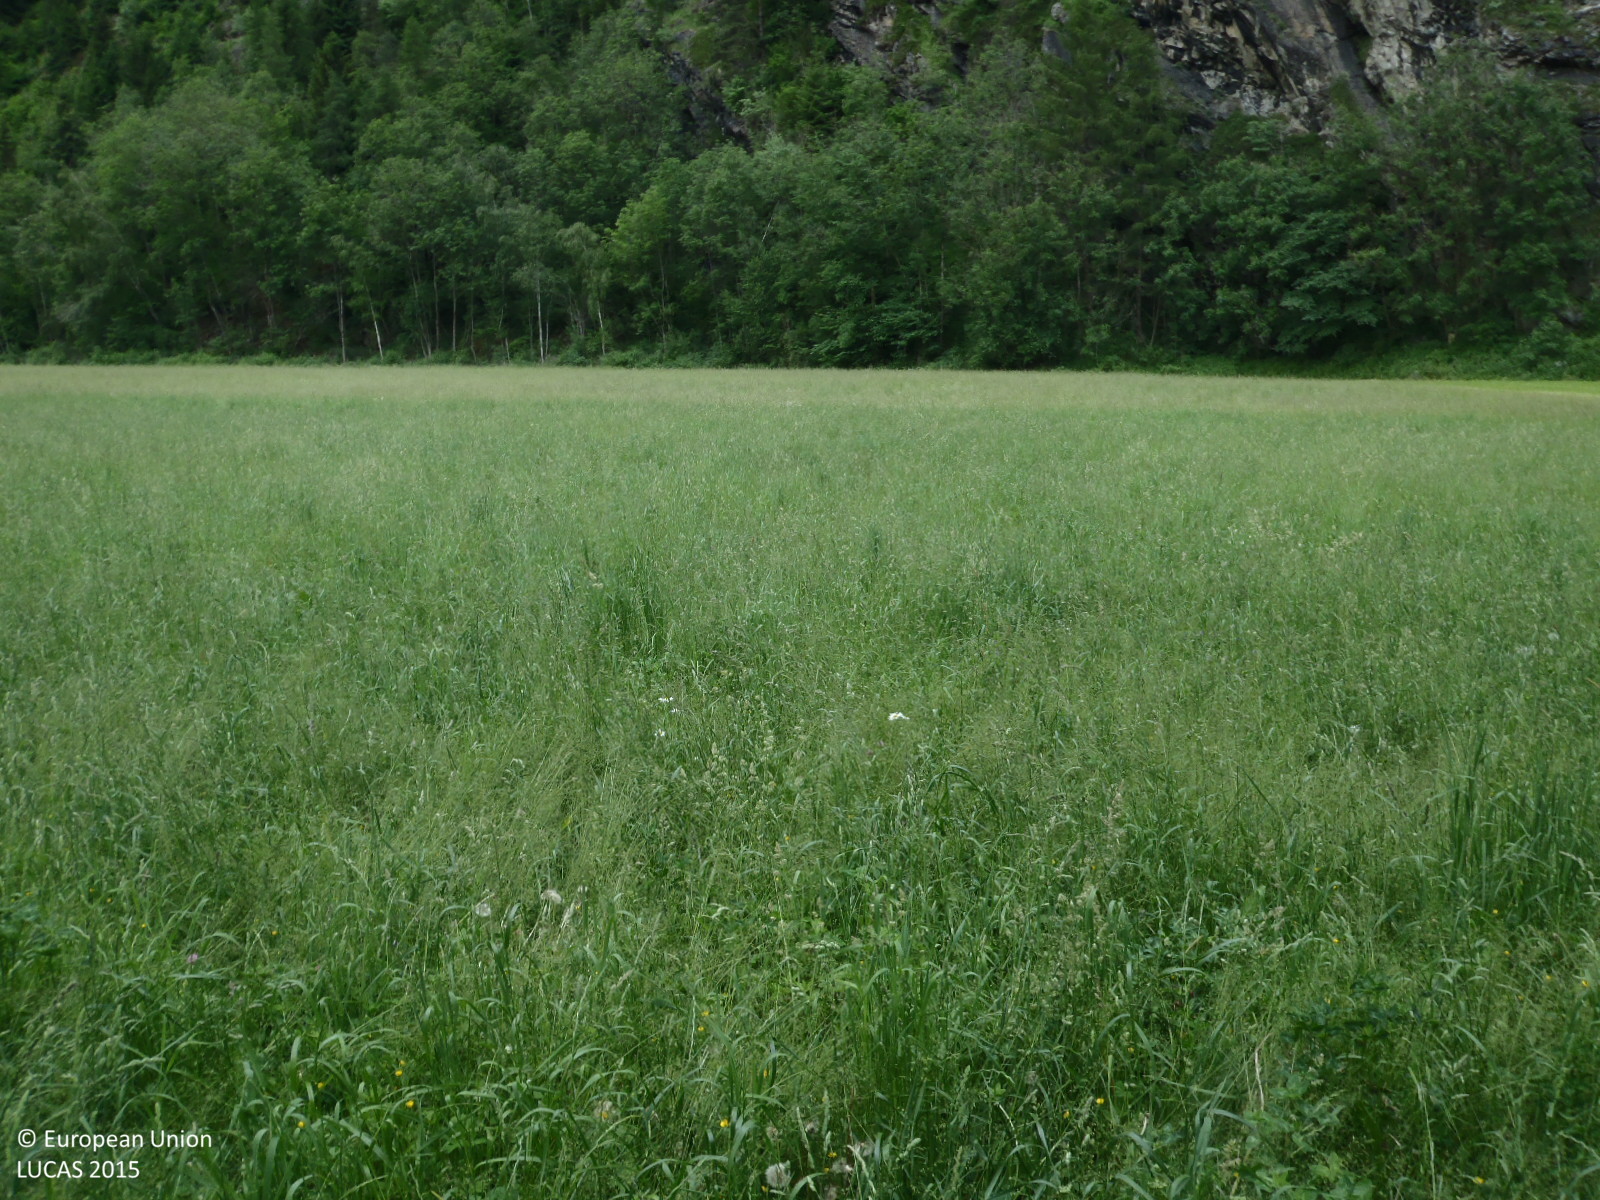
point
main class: Grassland
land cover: Grassland without tree/shrub cover
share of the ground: > 75 %
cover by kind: herbaceous plants 100 %
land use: Agriculture (excluding fallow land and kitchen gardens)
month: June
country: AT
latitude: 47.1578
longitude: 10.9092
